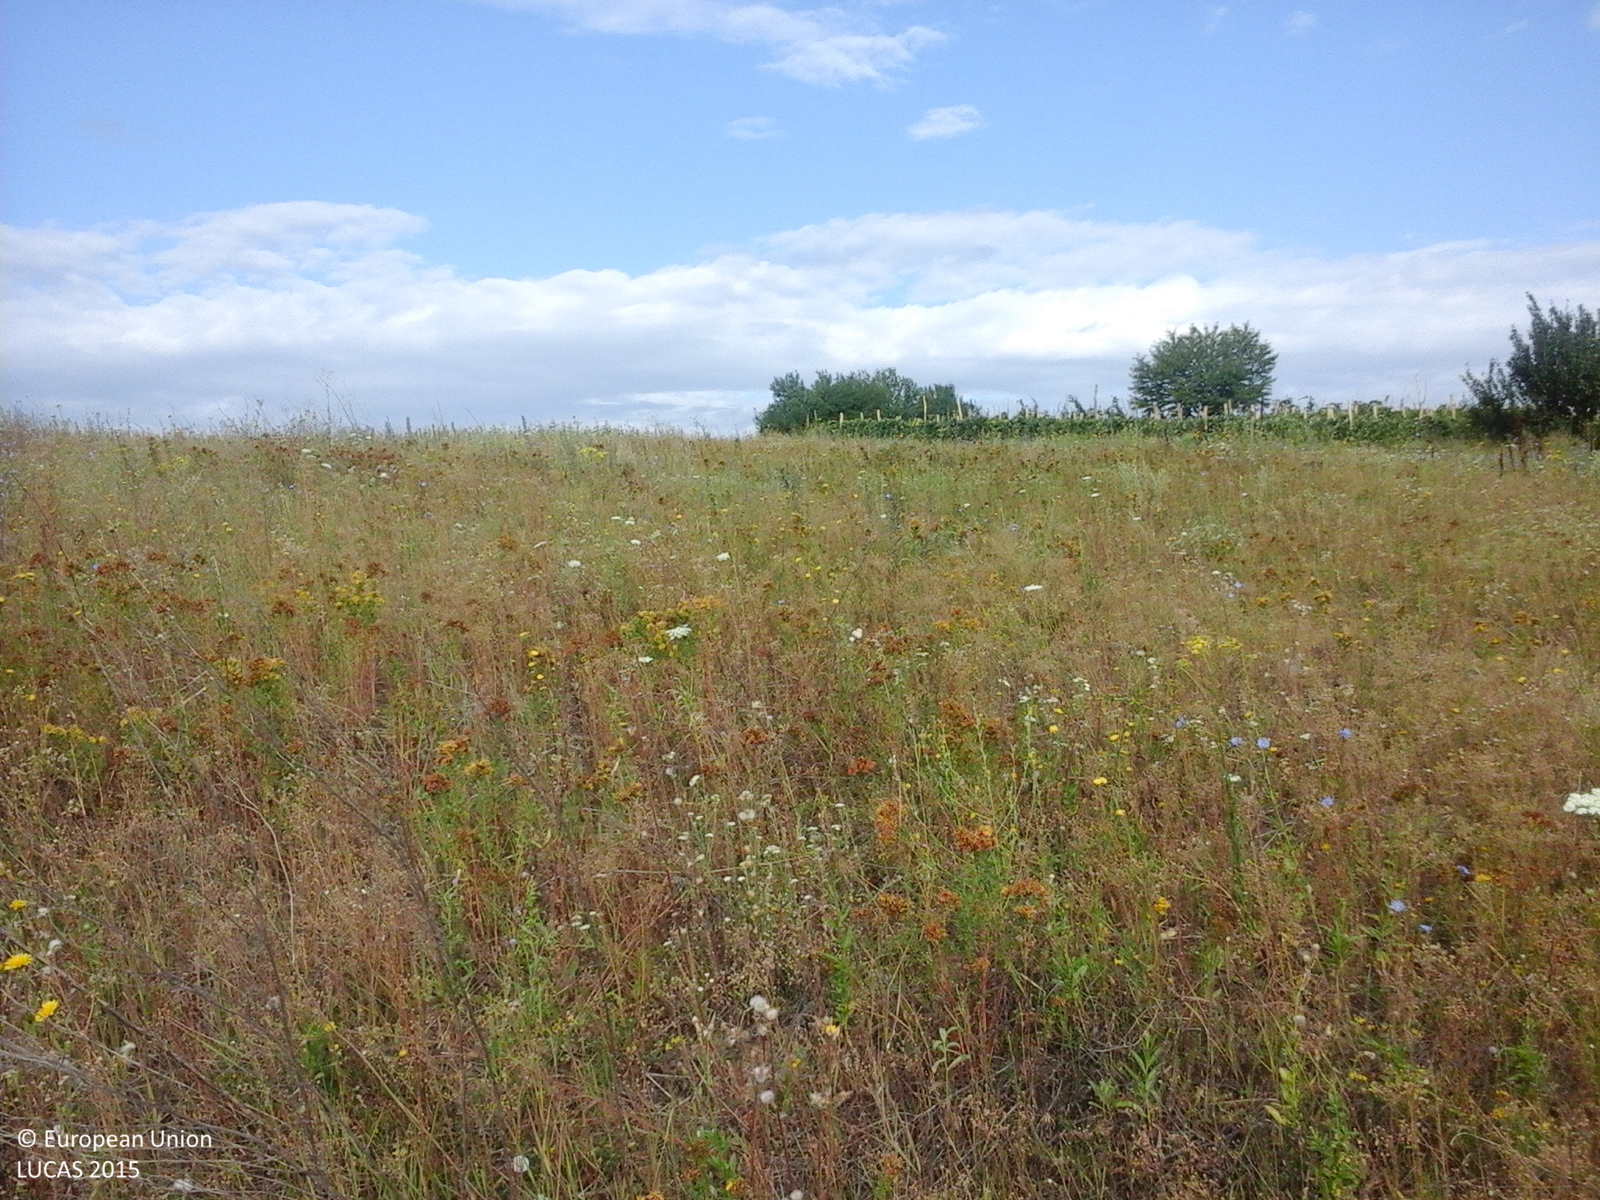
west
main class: Grassland
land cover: Spontaneously vegetated surfaces
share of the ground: > 75 %
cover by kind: herbaceous plants 100 %
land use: Semi-natural and natural areas not in use
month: July
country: RO
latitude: 46.6634
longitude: 27.2650
